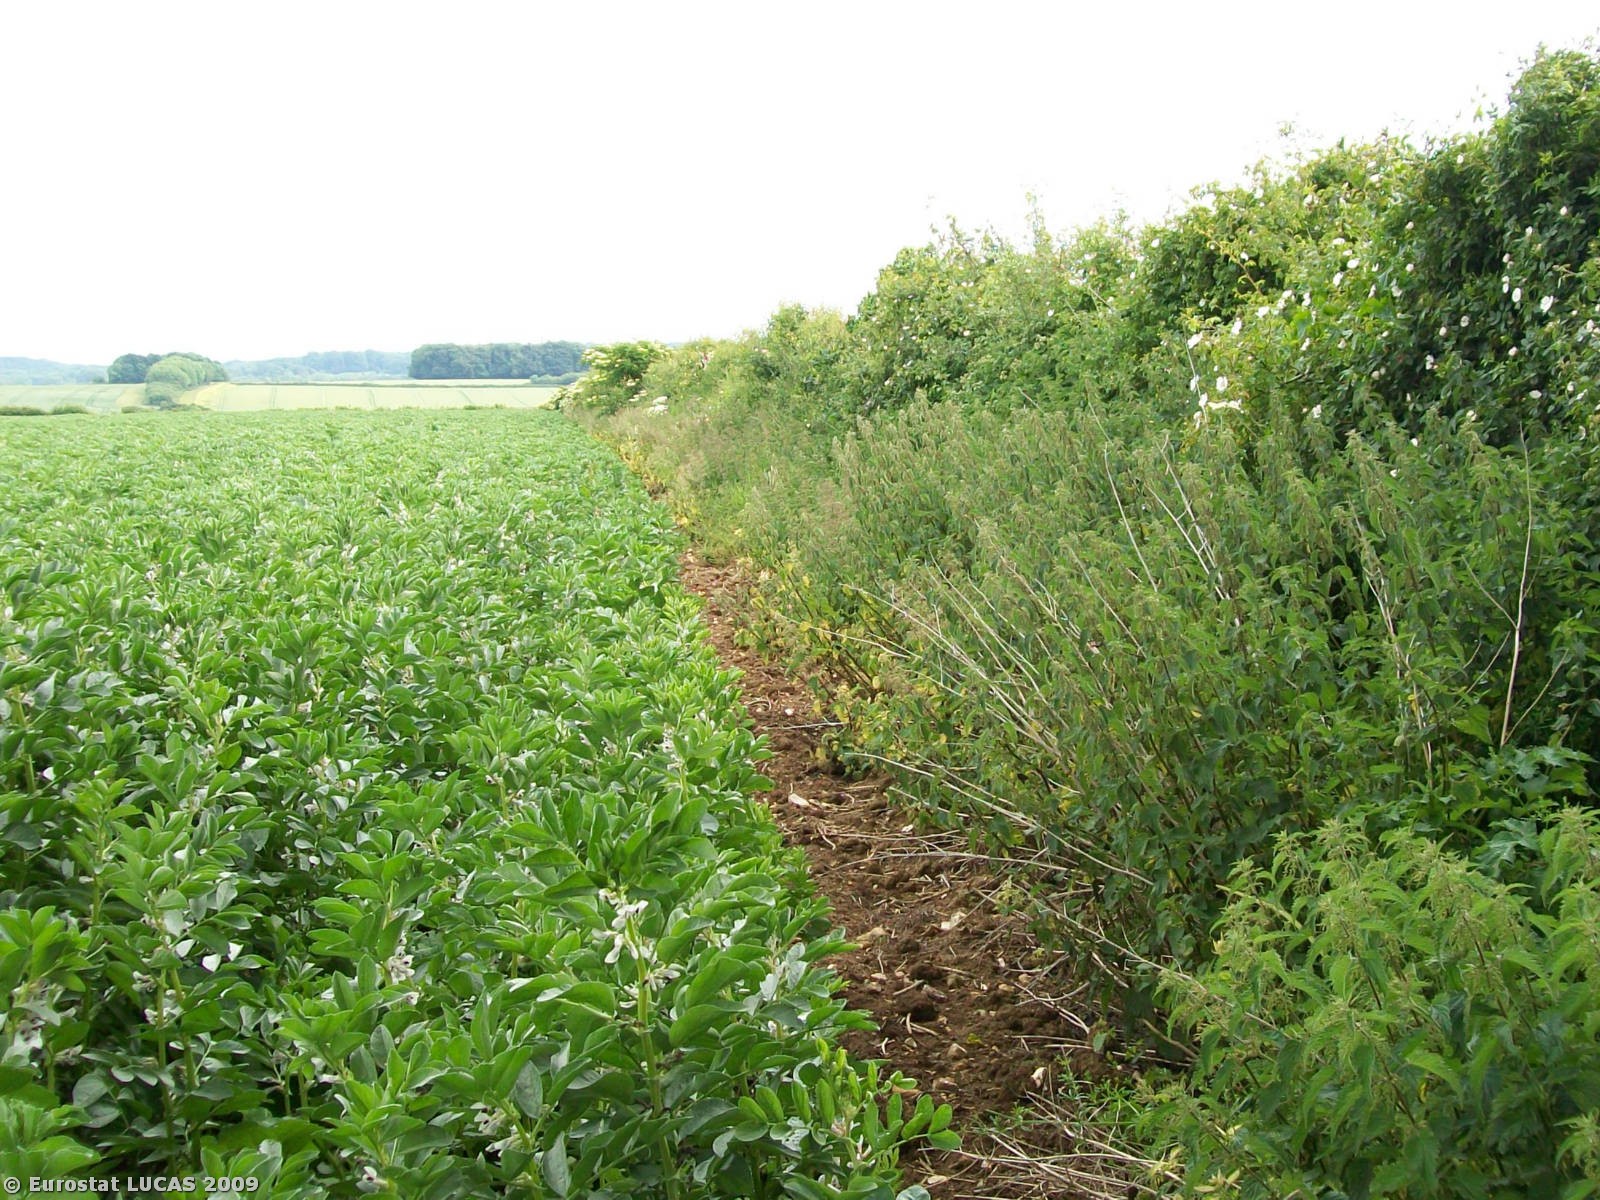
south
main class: Cropland
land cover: Dry pulses
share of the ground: > 75 %
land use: Agriculture (excluding fallow land and kitchen gardens)
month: June
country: GB
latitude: 50.8062
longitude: -2.1364
